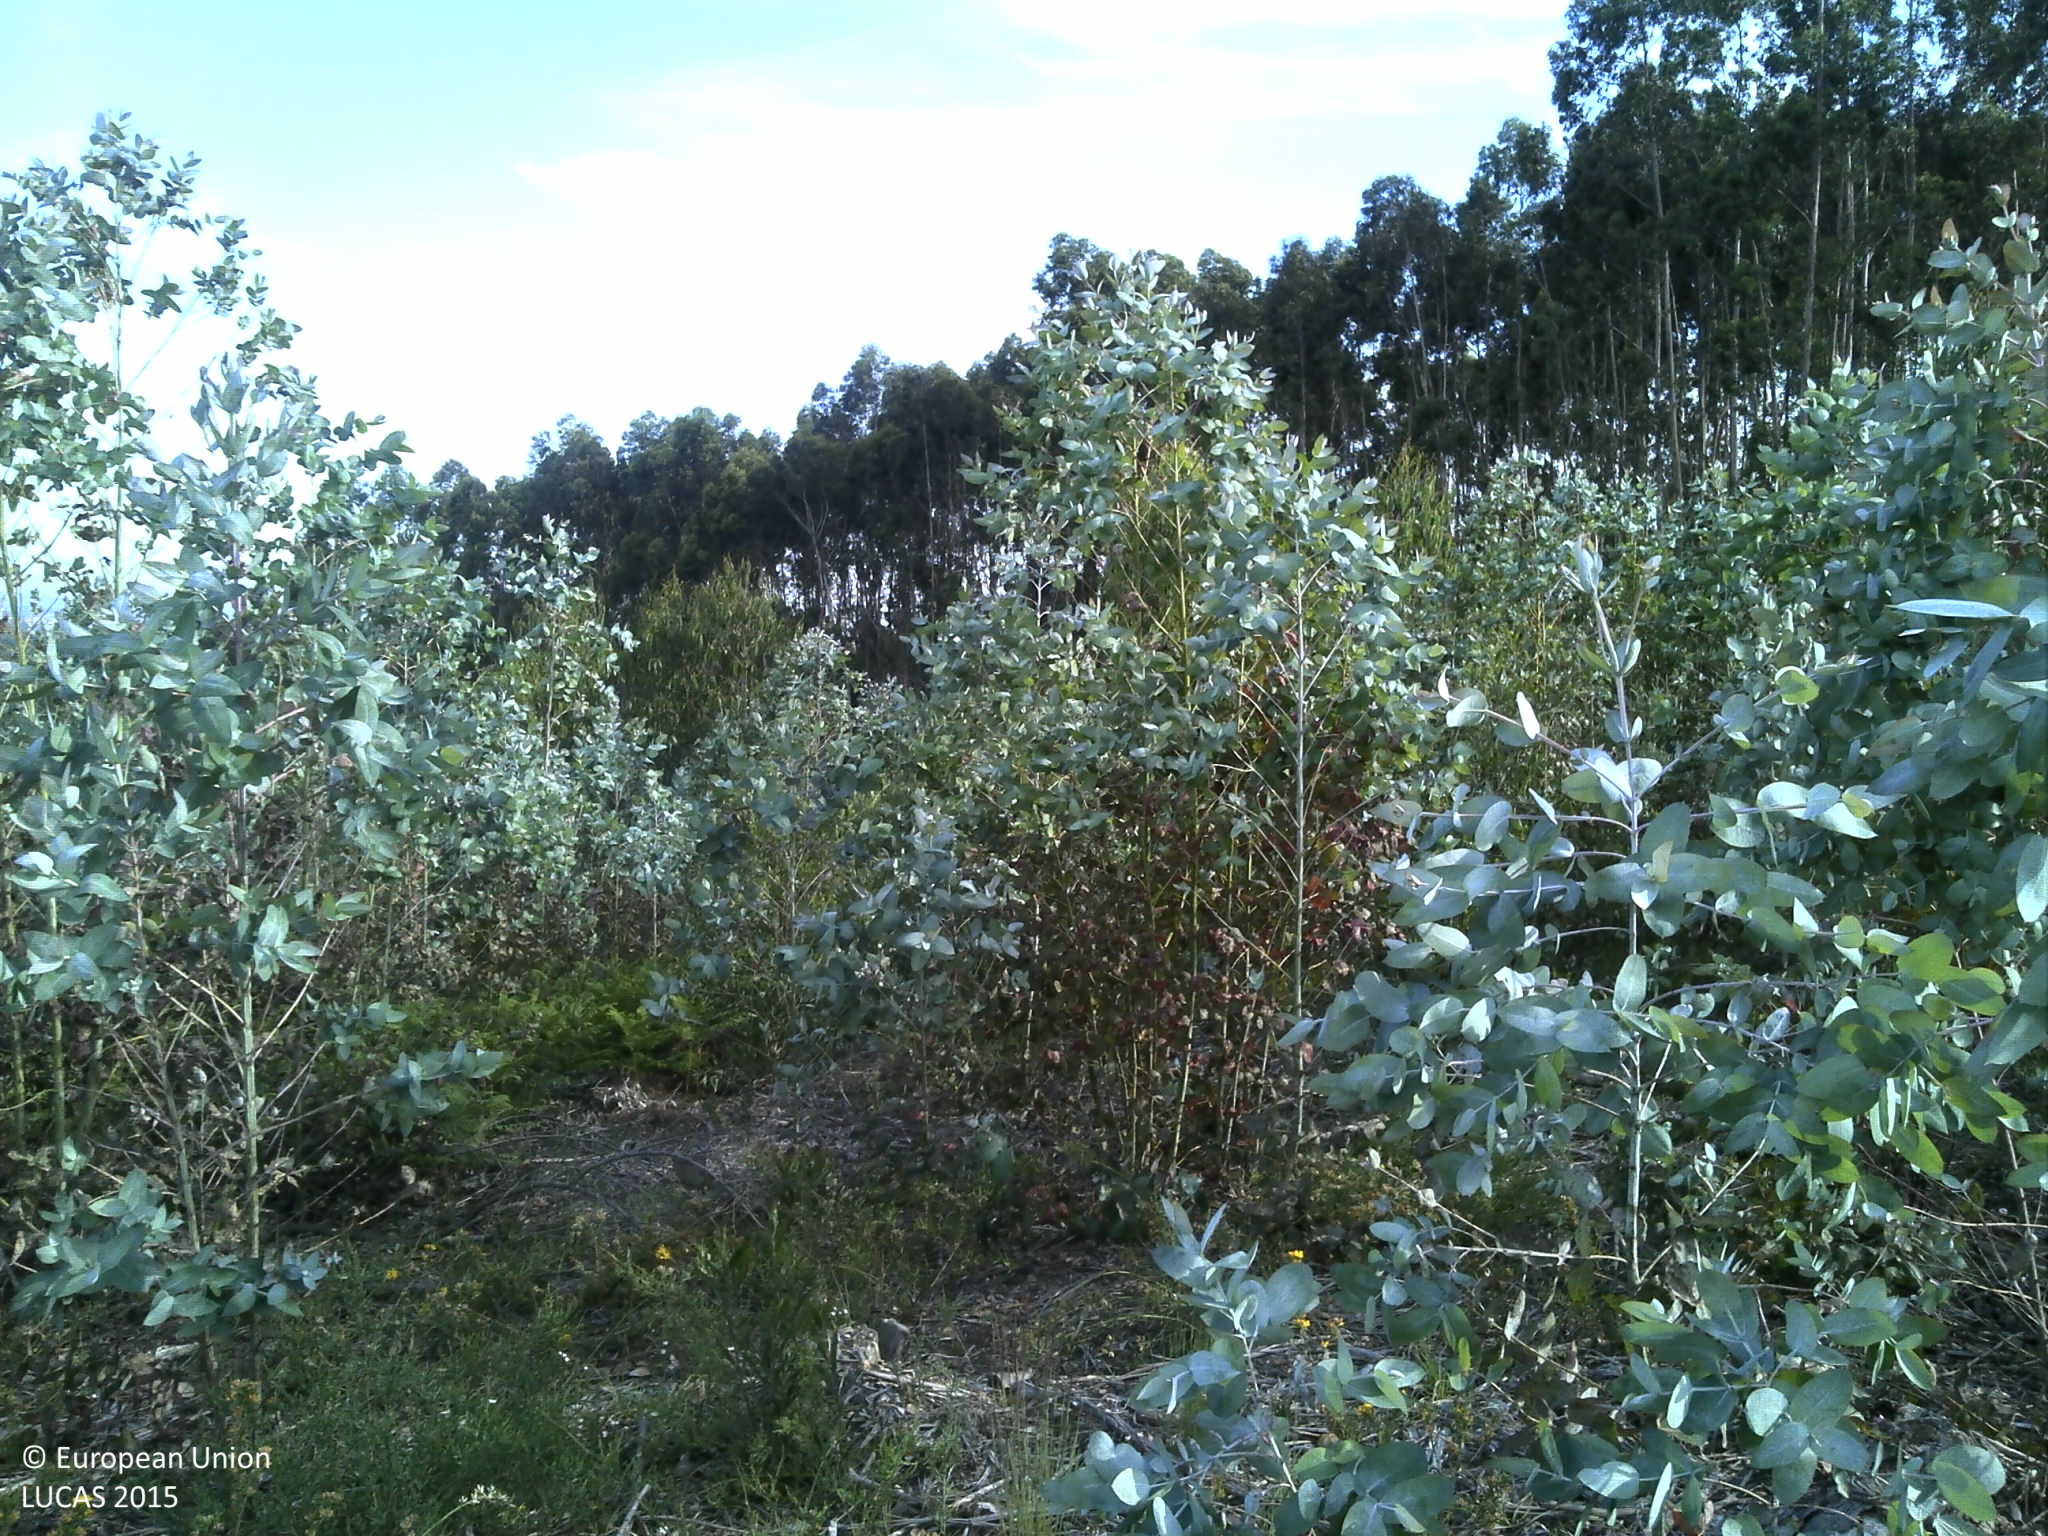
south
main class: Woodland
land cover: Broadleaved woodland
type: exotic forest
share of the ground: 10 - 25 %
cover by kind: unconsolidated bare surface 80 %, broadleaved forest trees 15 %, shrubs 5 %
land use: Forestry
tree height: < 5 m
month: May
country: PT
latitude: 40.9462
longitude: -8.5230
